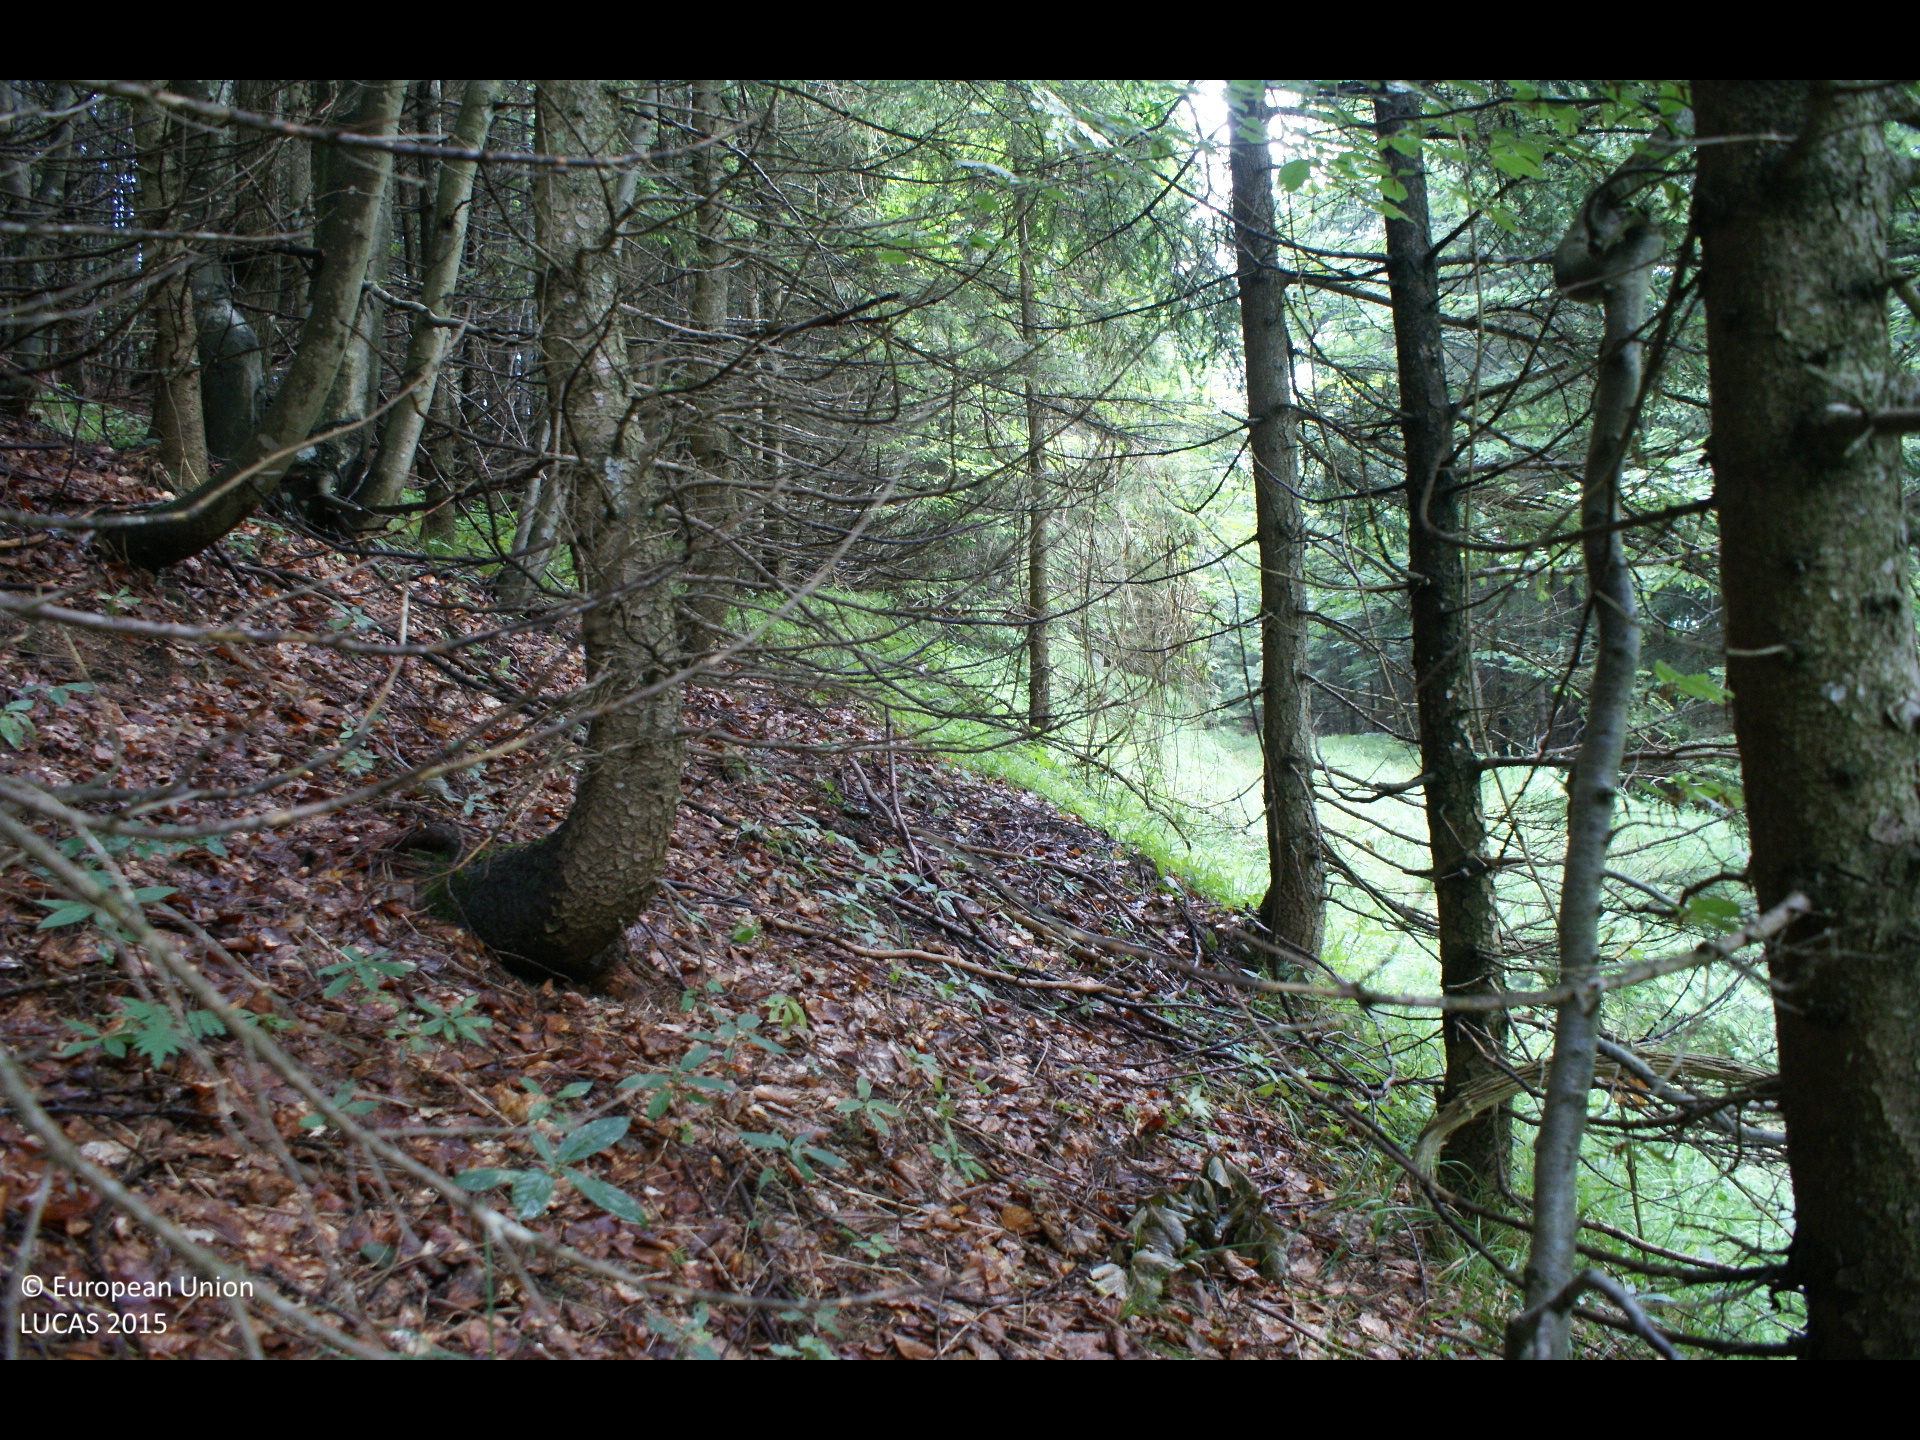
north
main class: Woodland
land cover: Spruce dominated coniferous woodland
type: alpine coniferous forest
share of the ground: > 75 %
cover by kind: coniferous forest trees 80 %, broadleaved forest trees 15 %, herbaceous plants 5 %
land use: Forestry
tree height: > 5 m
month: July
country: AT
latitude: 47.8404
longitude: 14.9844
